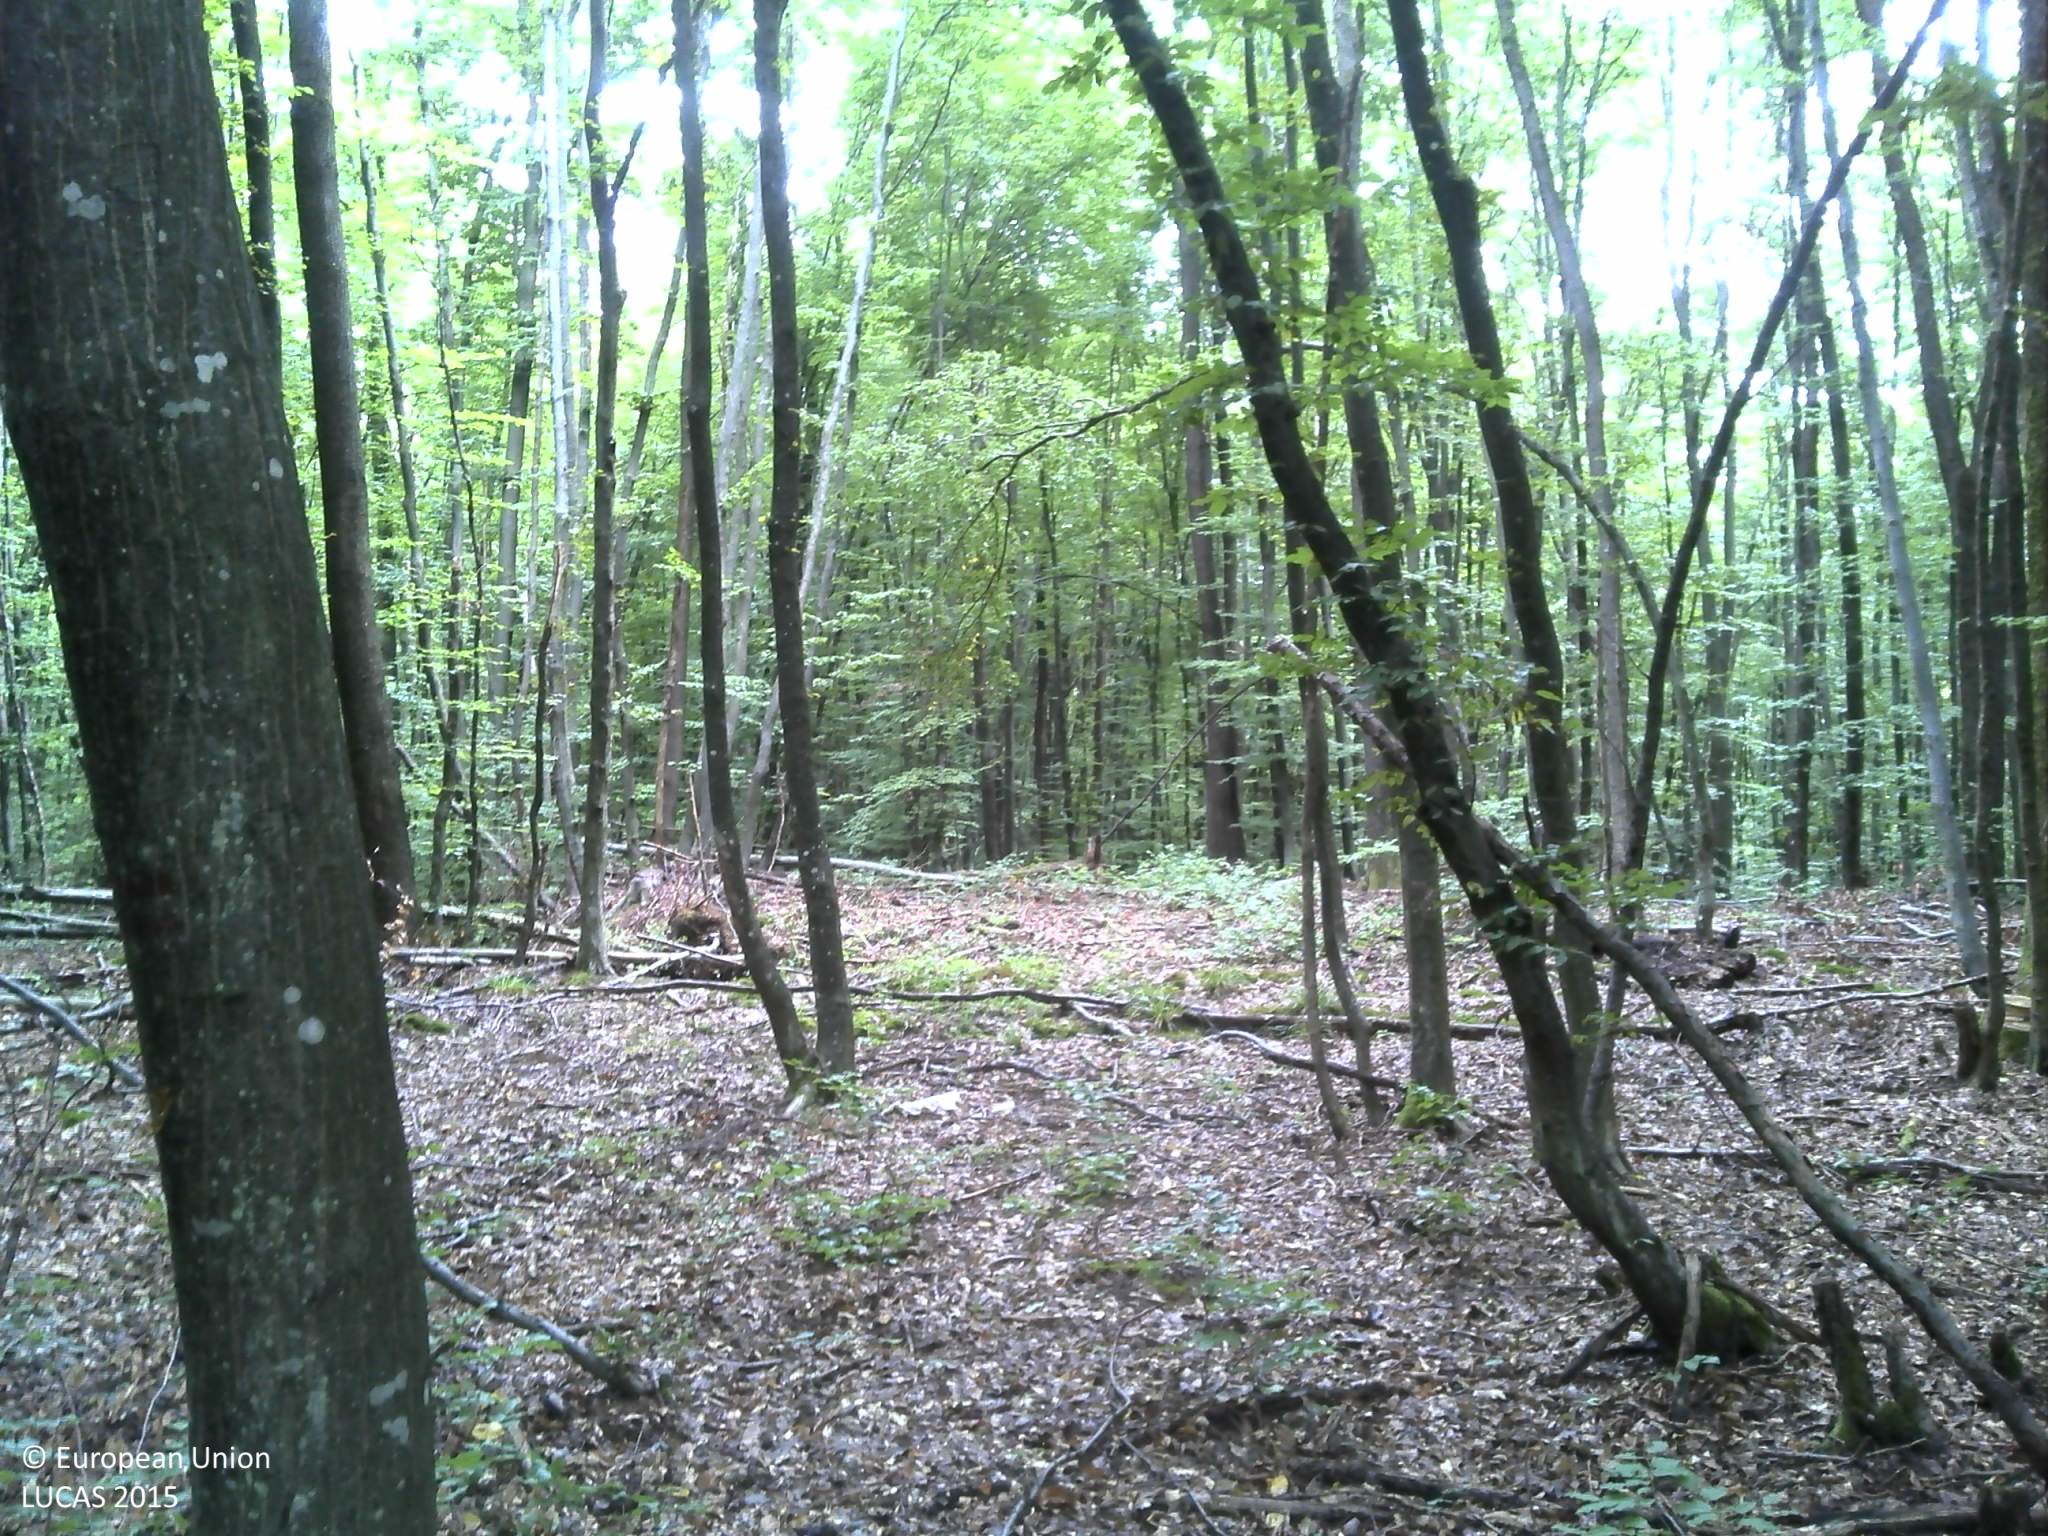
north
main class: Woodland
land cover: Broadleaved woodland
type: beech forest
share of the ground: > 75 %
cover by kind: broadleaved forest trees 100 %
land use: Forestry
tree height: > 5 m
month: August
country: HR
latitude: 45.4056
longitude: 15.6817
